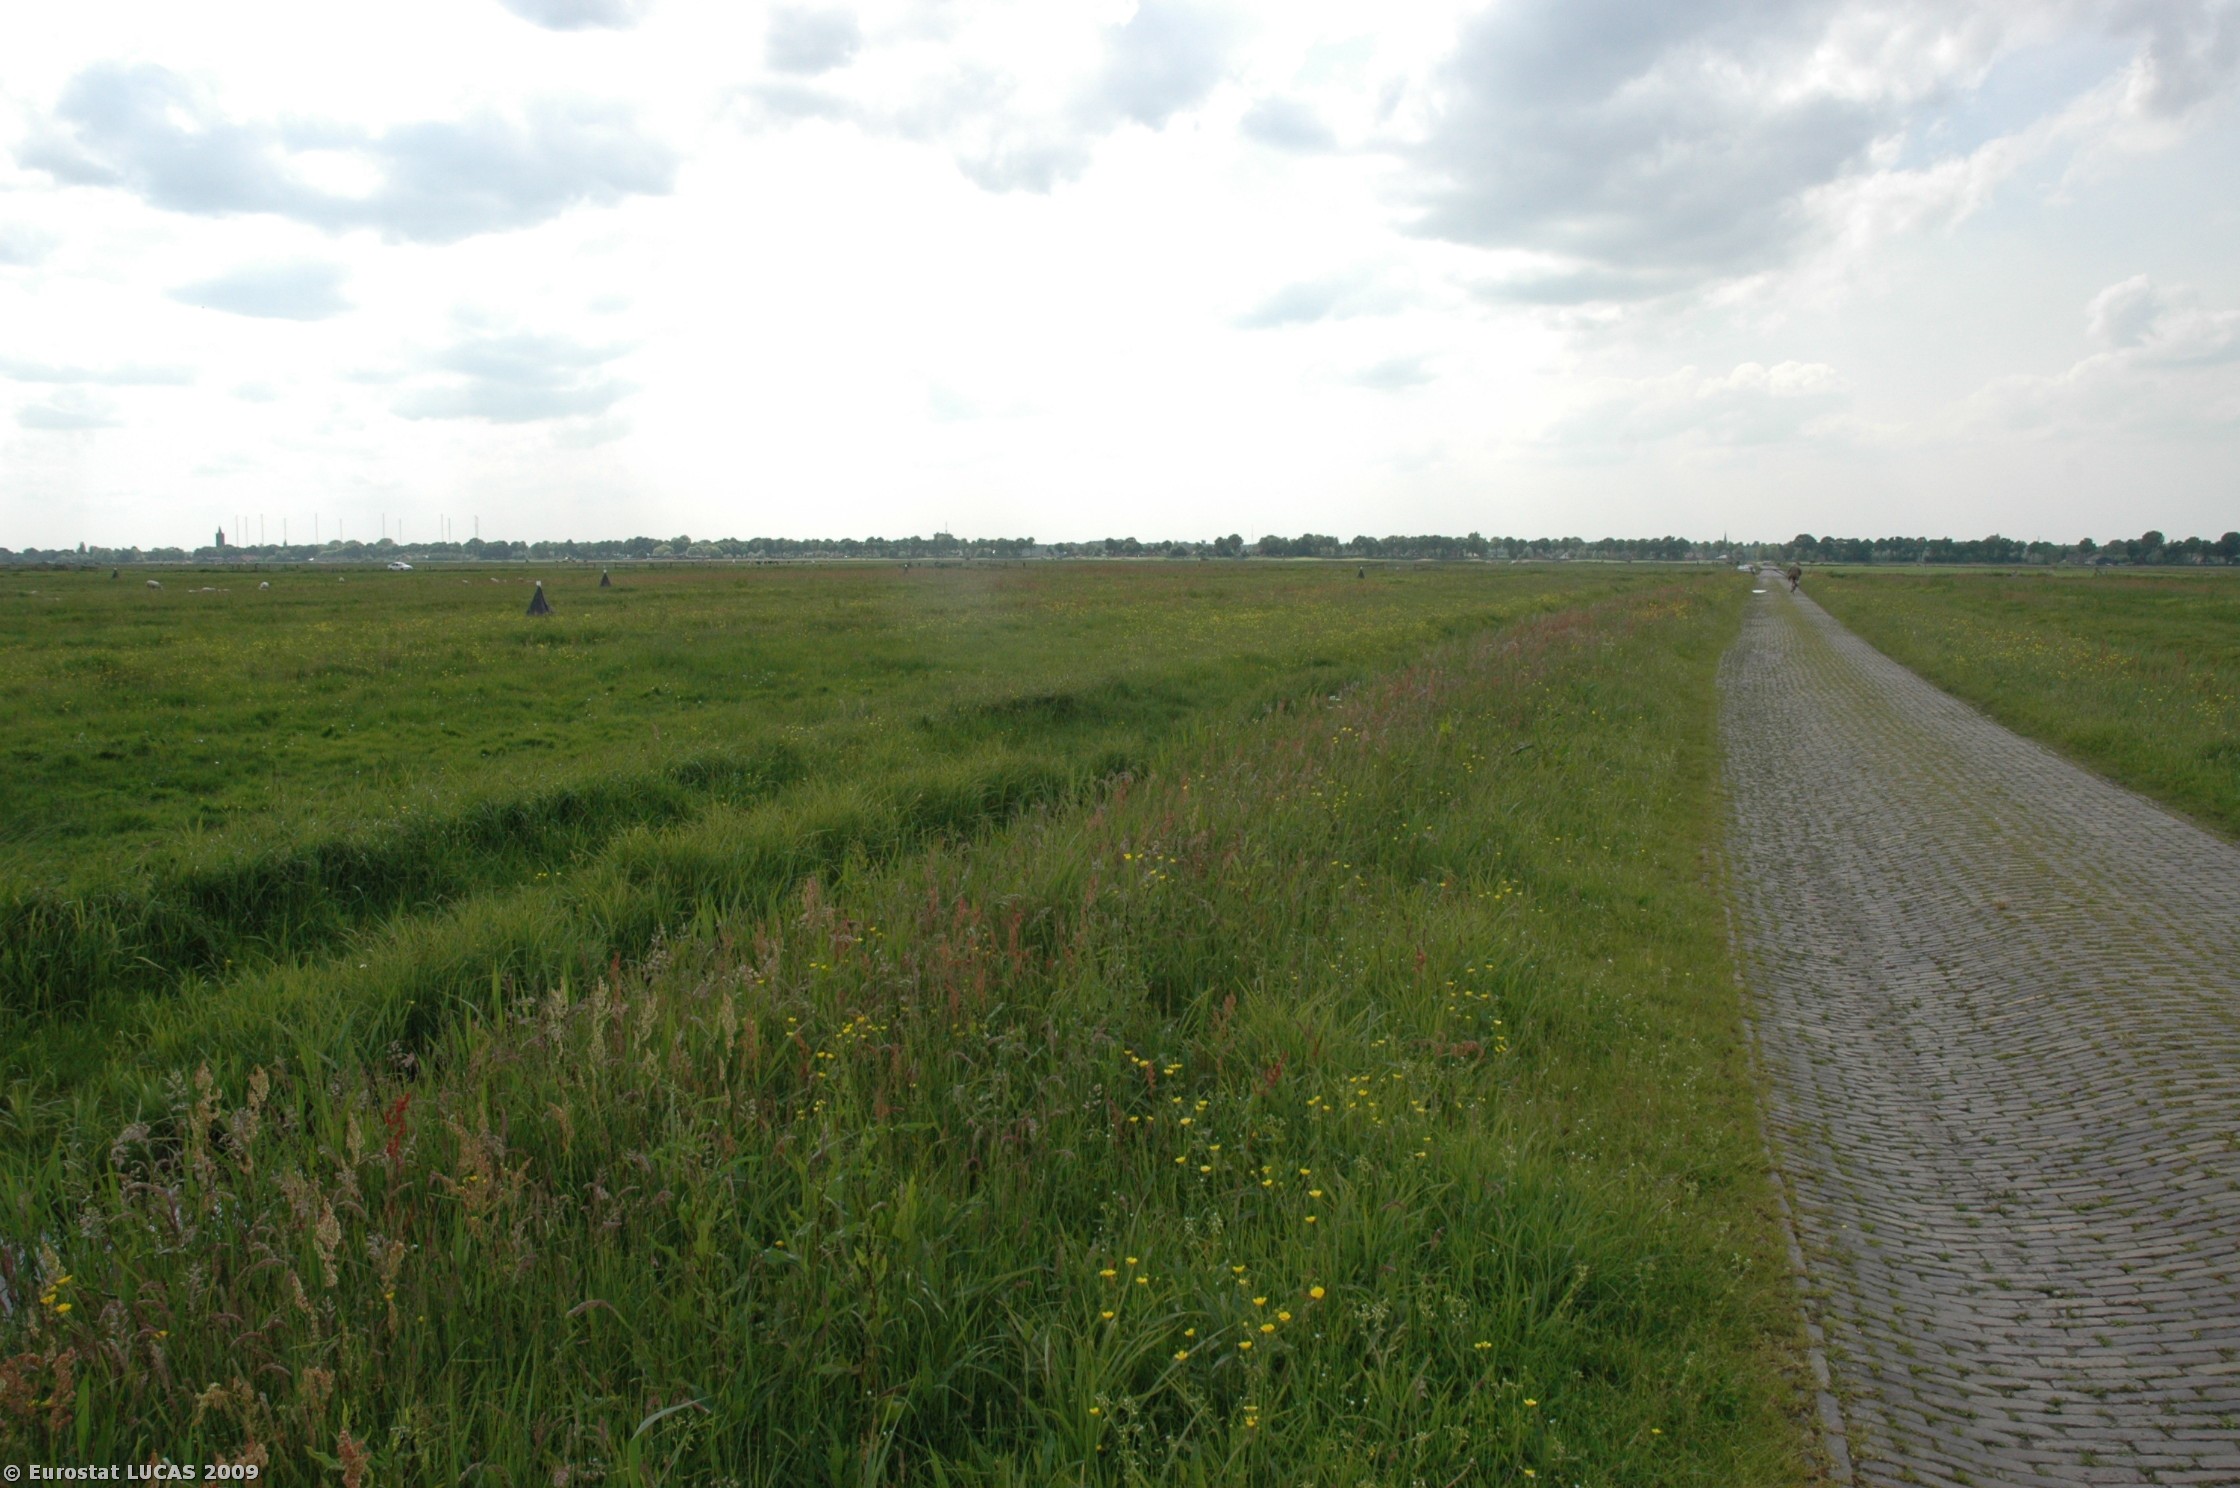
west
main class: Grassland
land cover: Grassland without tree/shrub cover
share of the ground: > 75 %
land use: Agriculture (excluding fallow land and kitchen gardens)
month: May
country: NL
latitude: 52.2662
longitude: 5.2943
